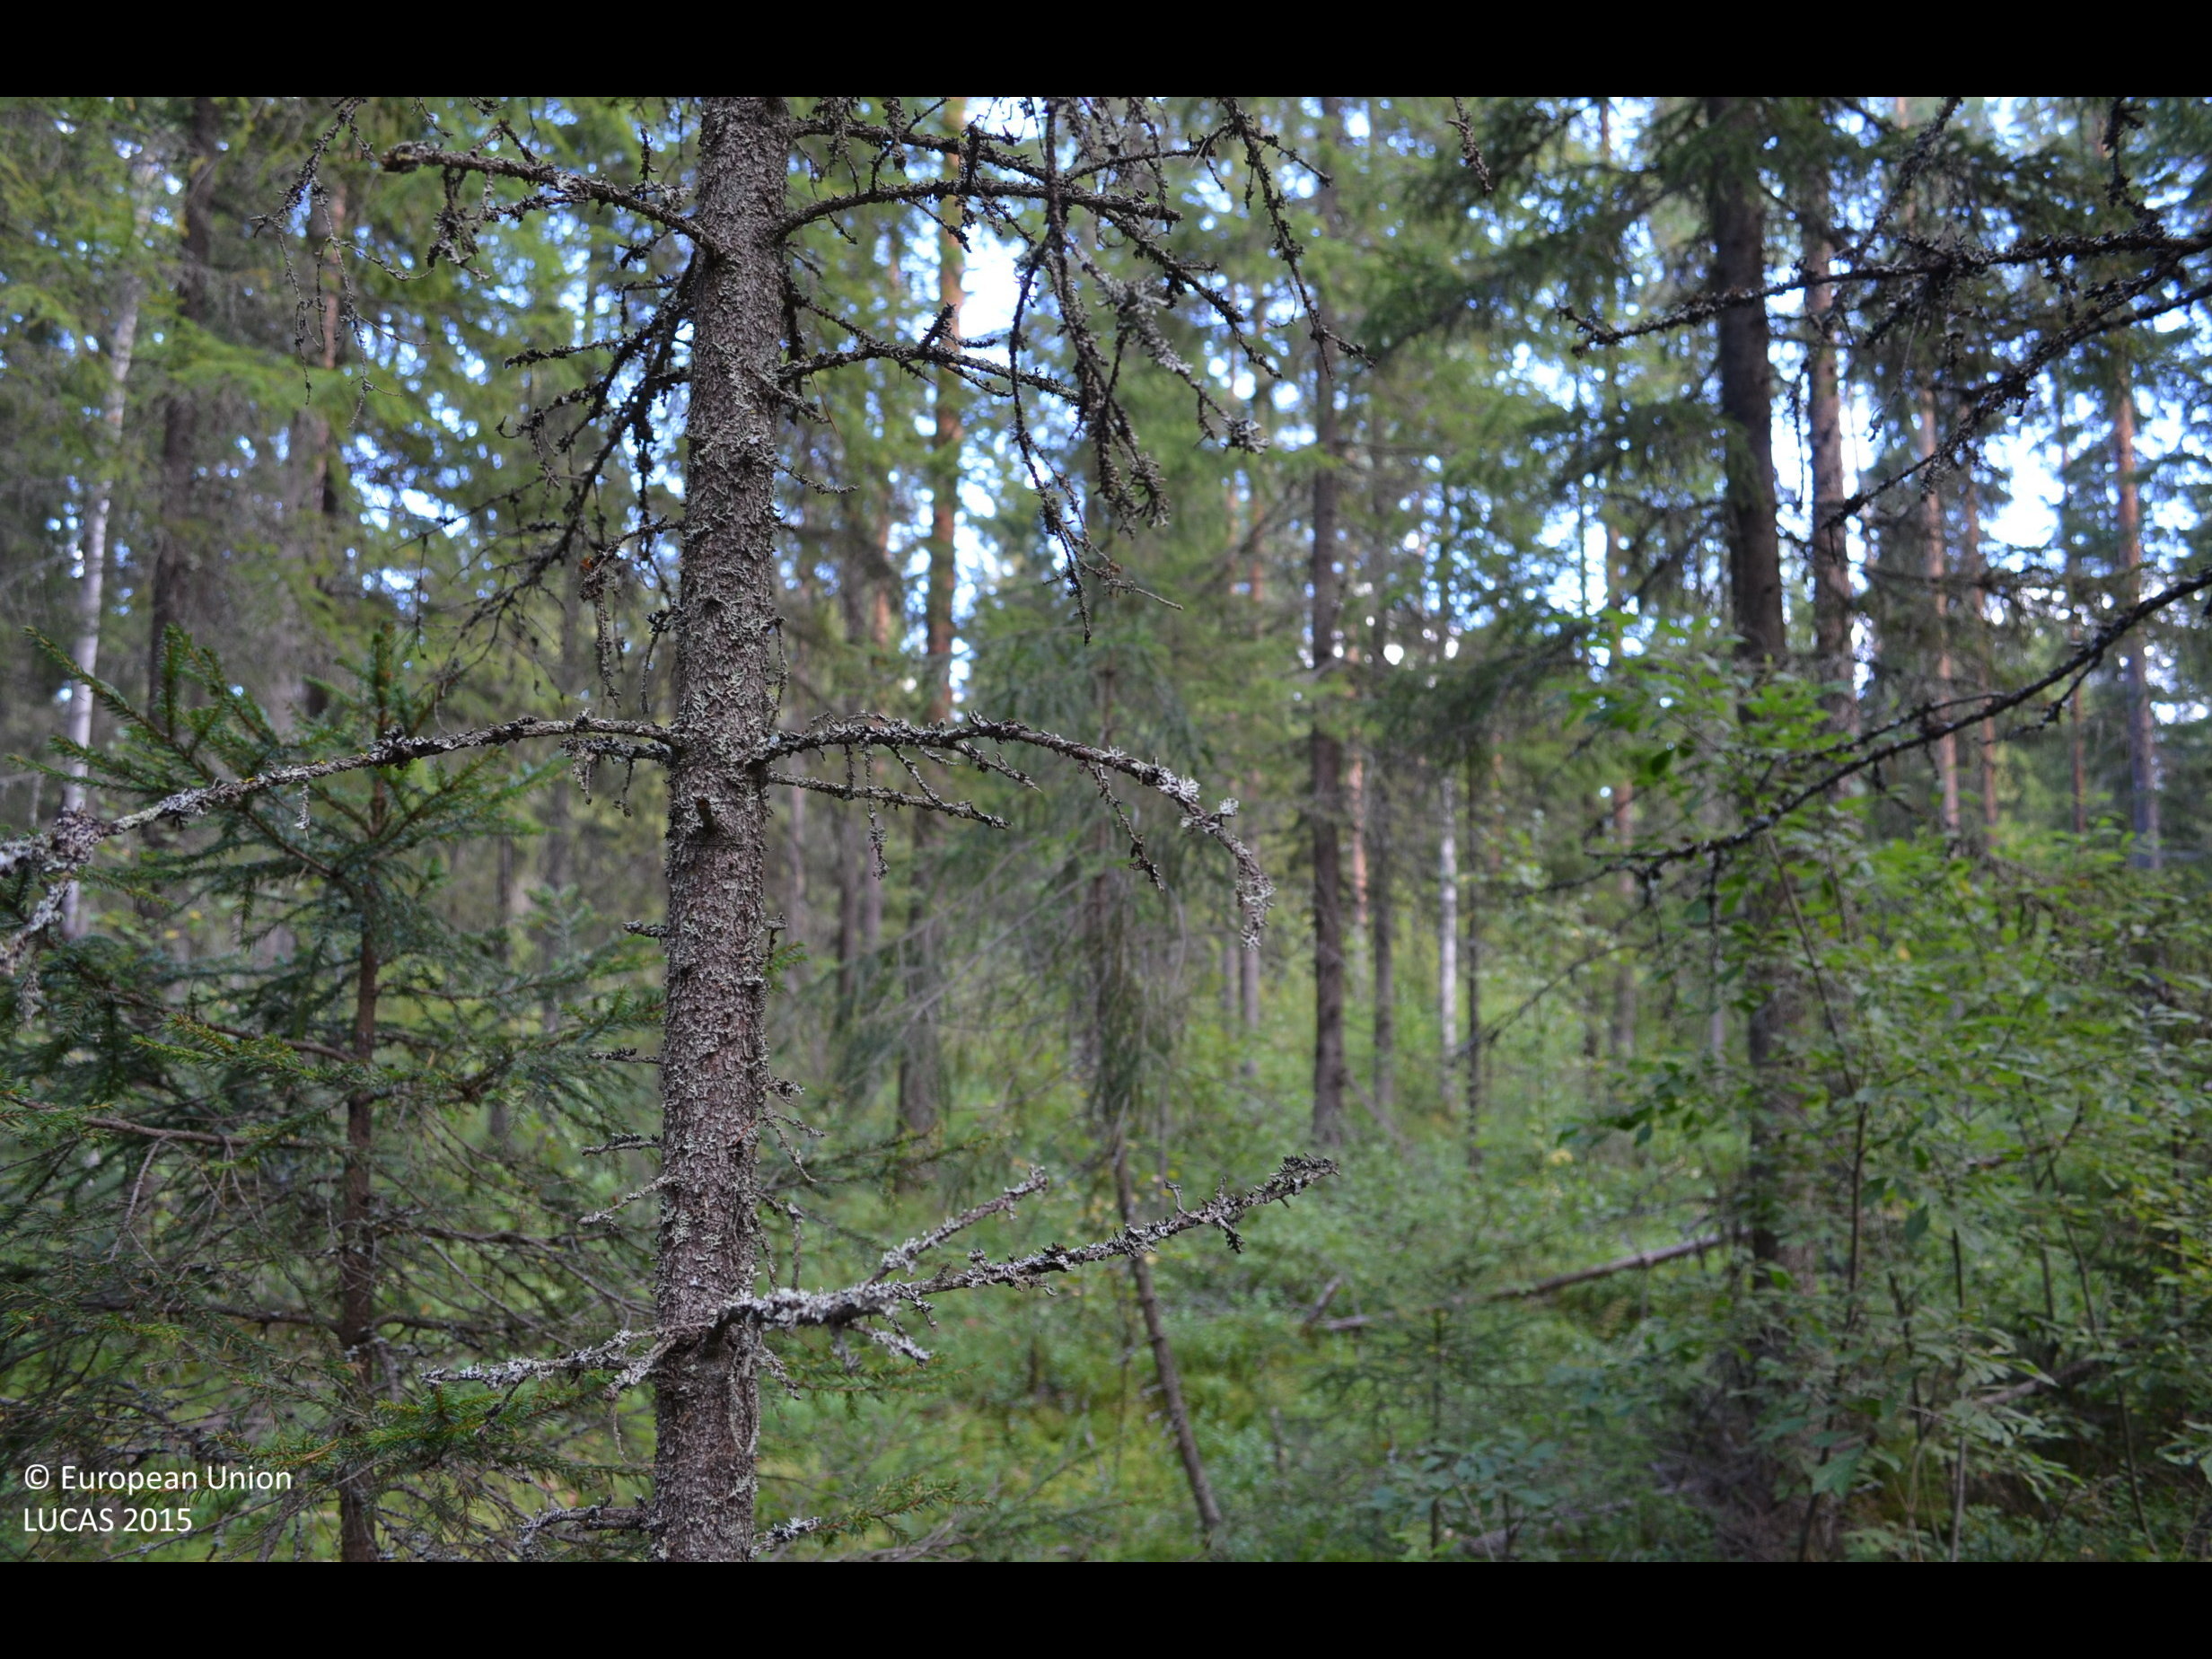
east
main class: Woodland
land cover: Other coniferous woodland
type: boreal forest
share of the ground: > 75 %
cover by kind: coniferous forest trees 70 %, shrubs 15 %, broadleaved forest trees 5 %, herbaceous plants 5 %, lichens and mosses 5 %
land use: Forestry
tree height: > 5 m
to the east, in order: Other coniferous woodland; Ditches and canals; Spruce dominated mixed woodland; Ditches and canals; Spruce dominated coniferous woodland; Pine dominated mixed woodland; Pine dominated coniferous woodland
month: August
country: FI
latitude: 62.3779
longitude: 23.5878
